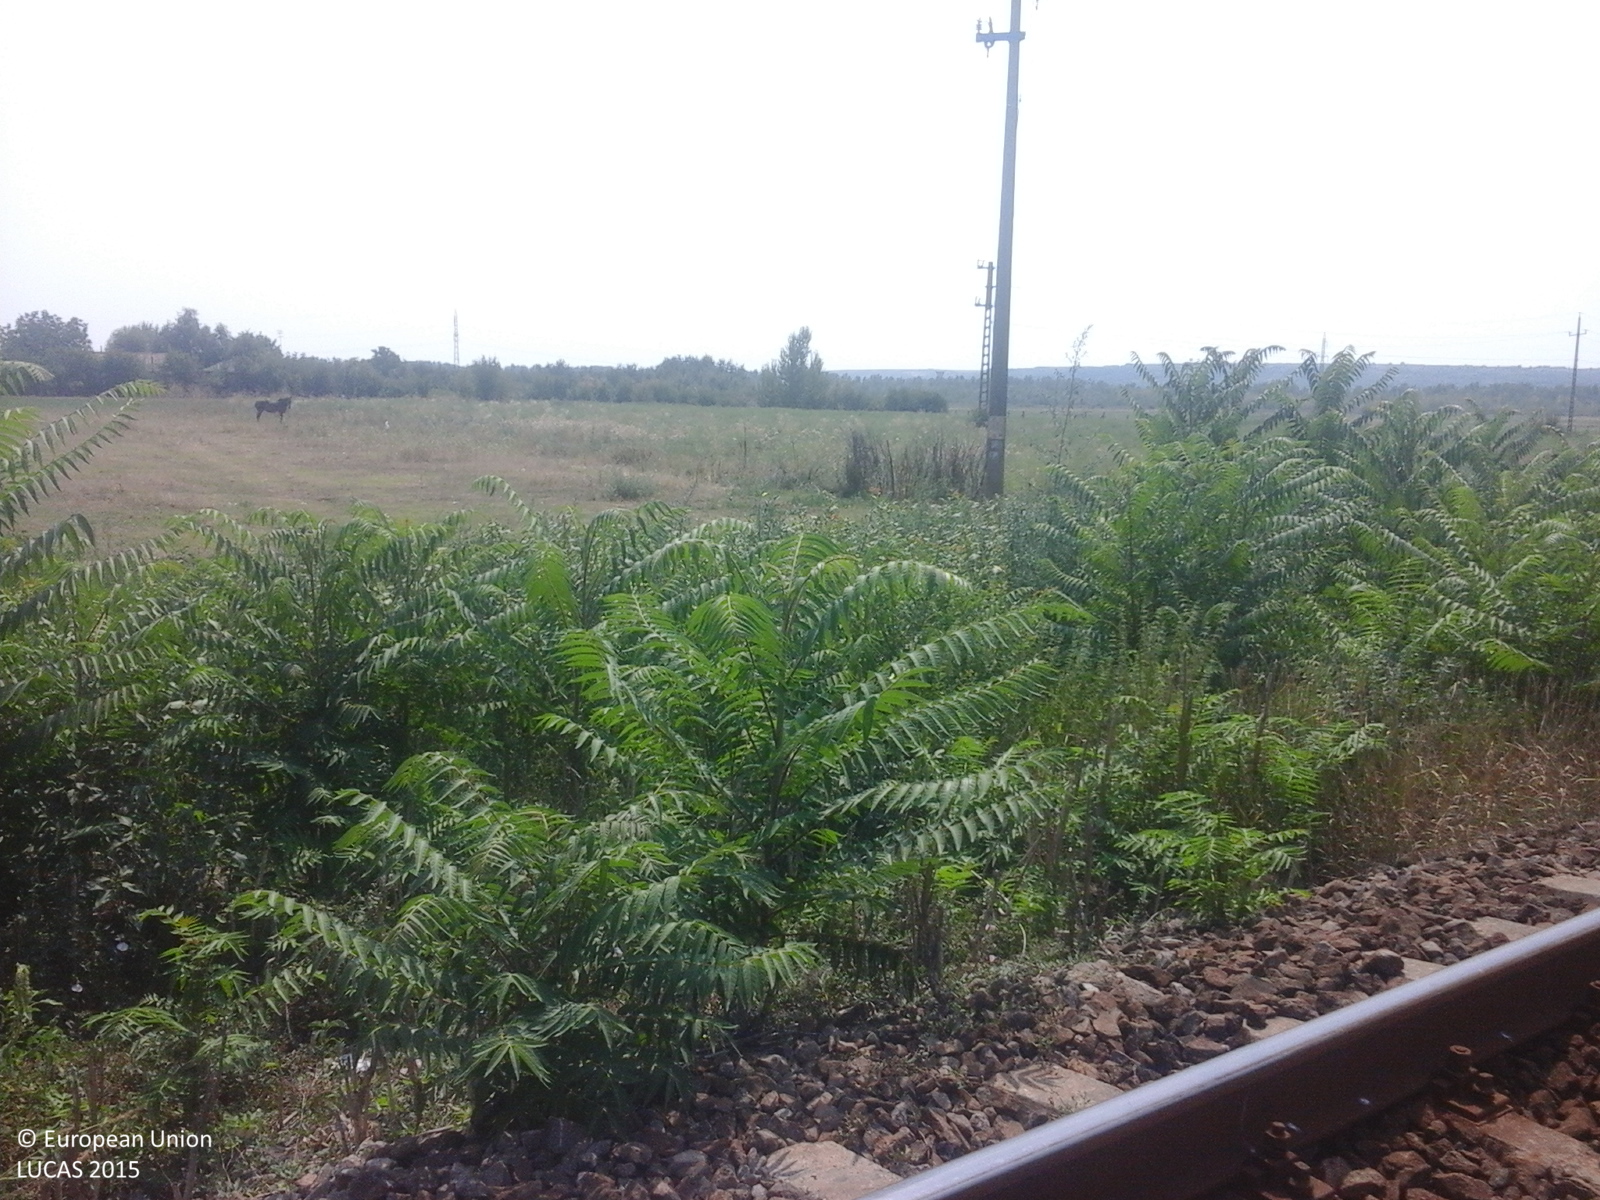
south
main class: Cropland
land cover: Vineyards
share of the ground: > 75 %
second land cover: Grassland without tree/shrub cover
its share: 10 - 25 %
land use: Agriculture (excluding fallow land and kitchen gardens)
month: August
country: RO
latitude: 44.2644
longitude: 23.7980
